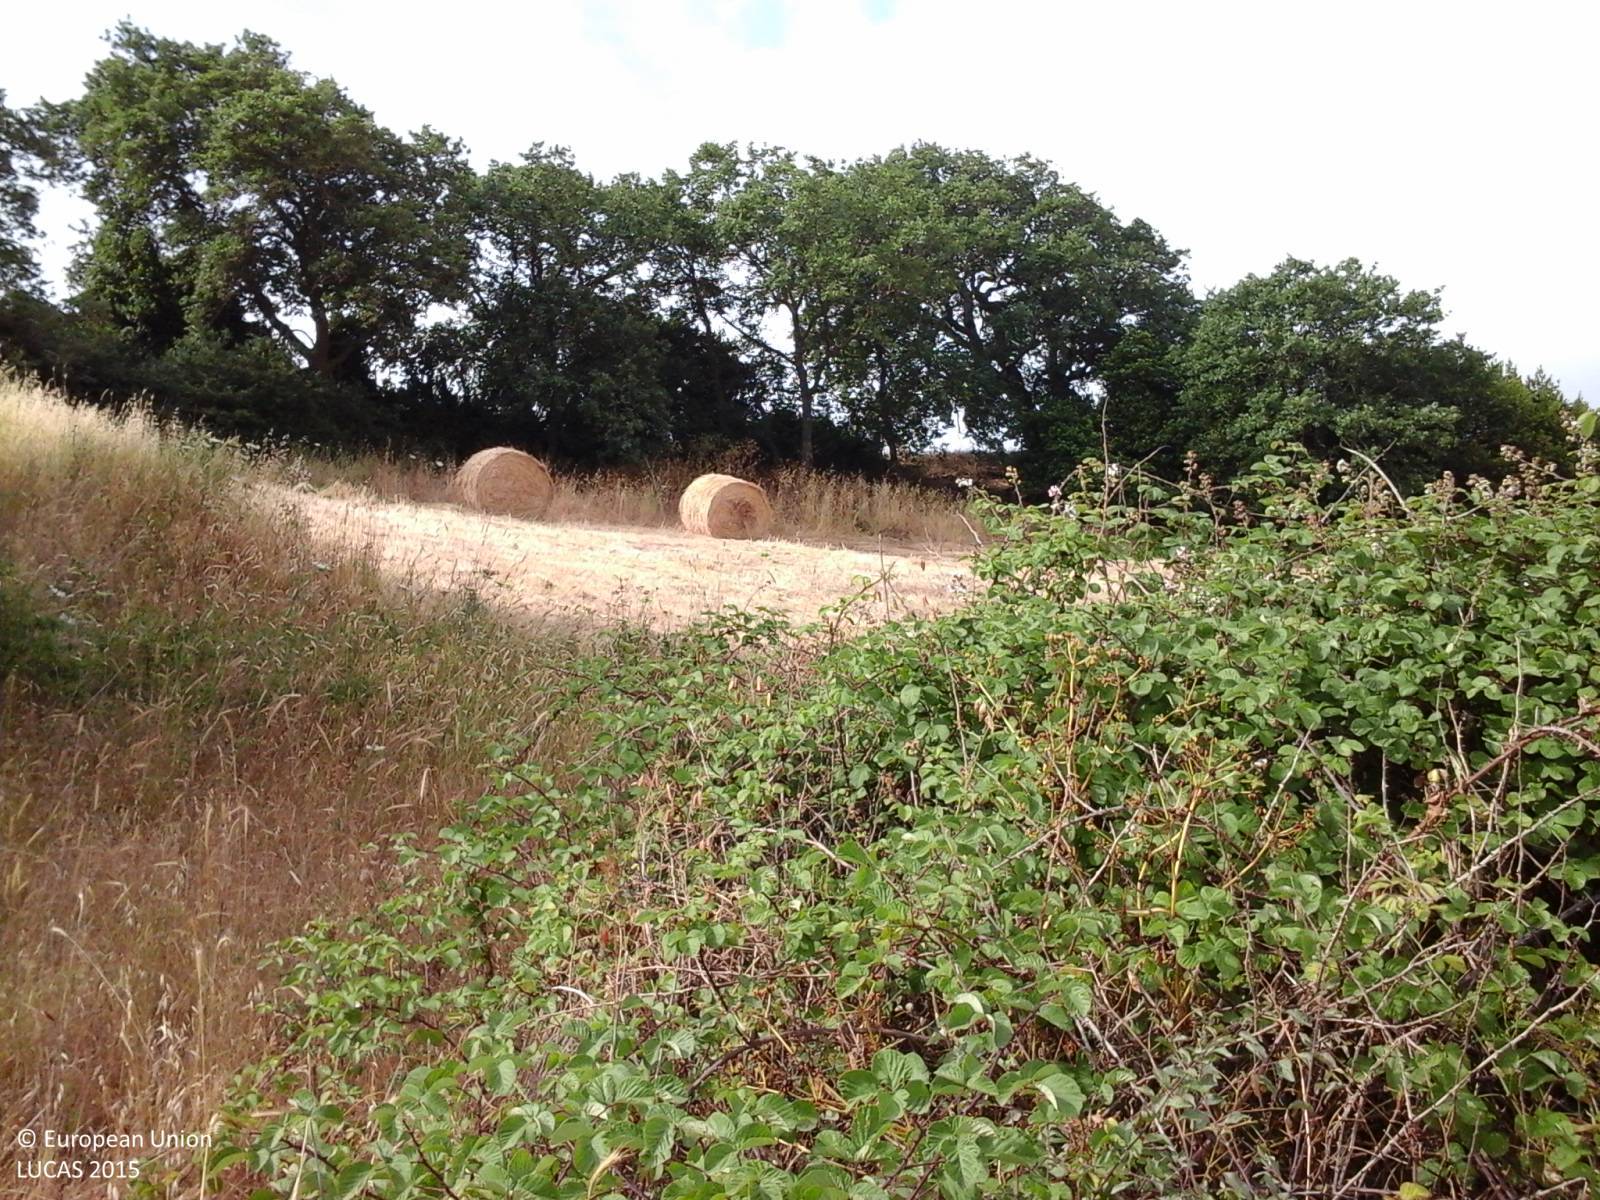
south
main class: Shrubland
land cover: Shrubland without tree cover
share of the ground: > 75 %
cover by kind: herbaceous plants 55 %, shrubs 45 %
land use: Agriculture (excluding fallow land and kitchen gardens)
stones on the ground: < 10 %
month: June
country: IT
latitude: 40.7651
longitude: 8.6677
